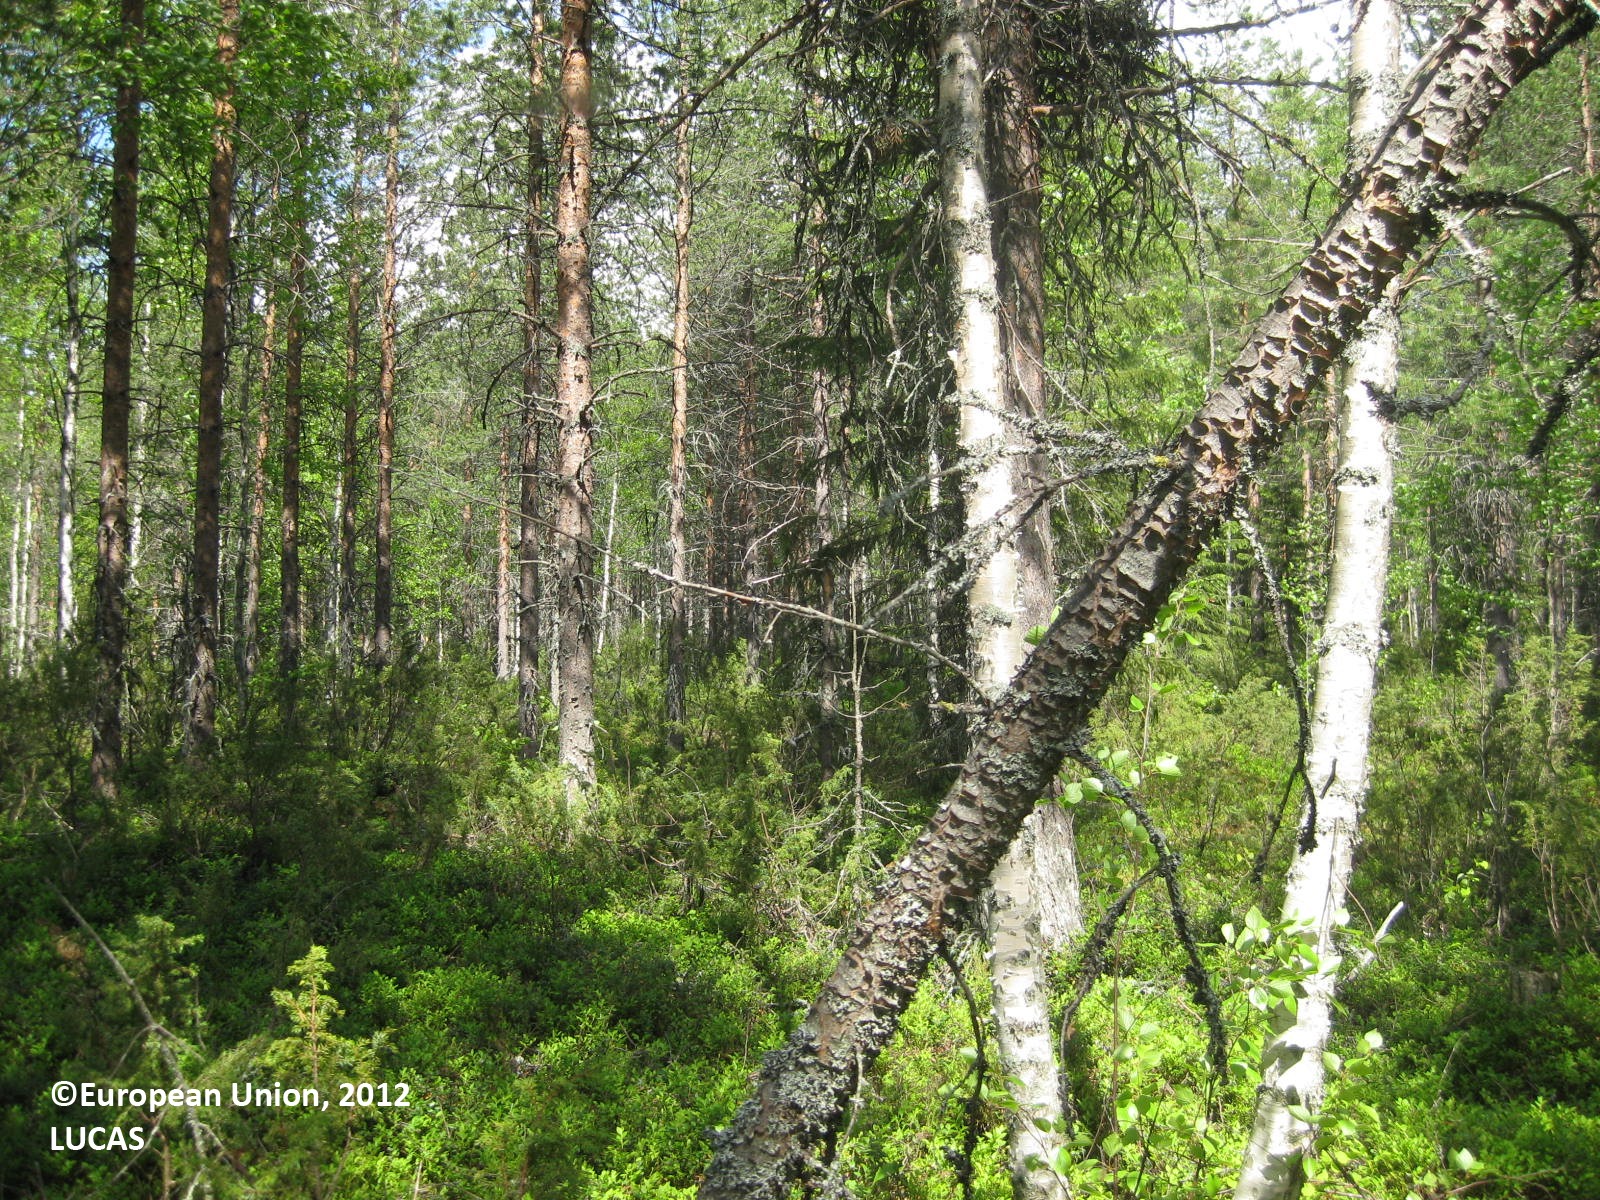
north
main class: Woodland
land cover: Pine dominated mixed woodland
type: boreal forest
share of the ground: > 75 %
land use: Forestry
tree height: > 5 m
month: June
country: FI
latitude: 65.0146
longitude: 28.9635
